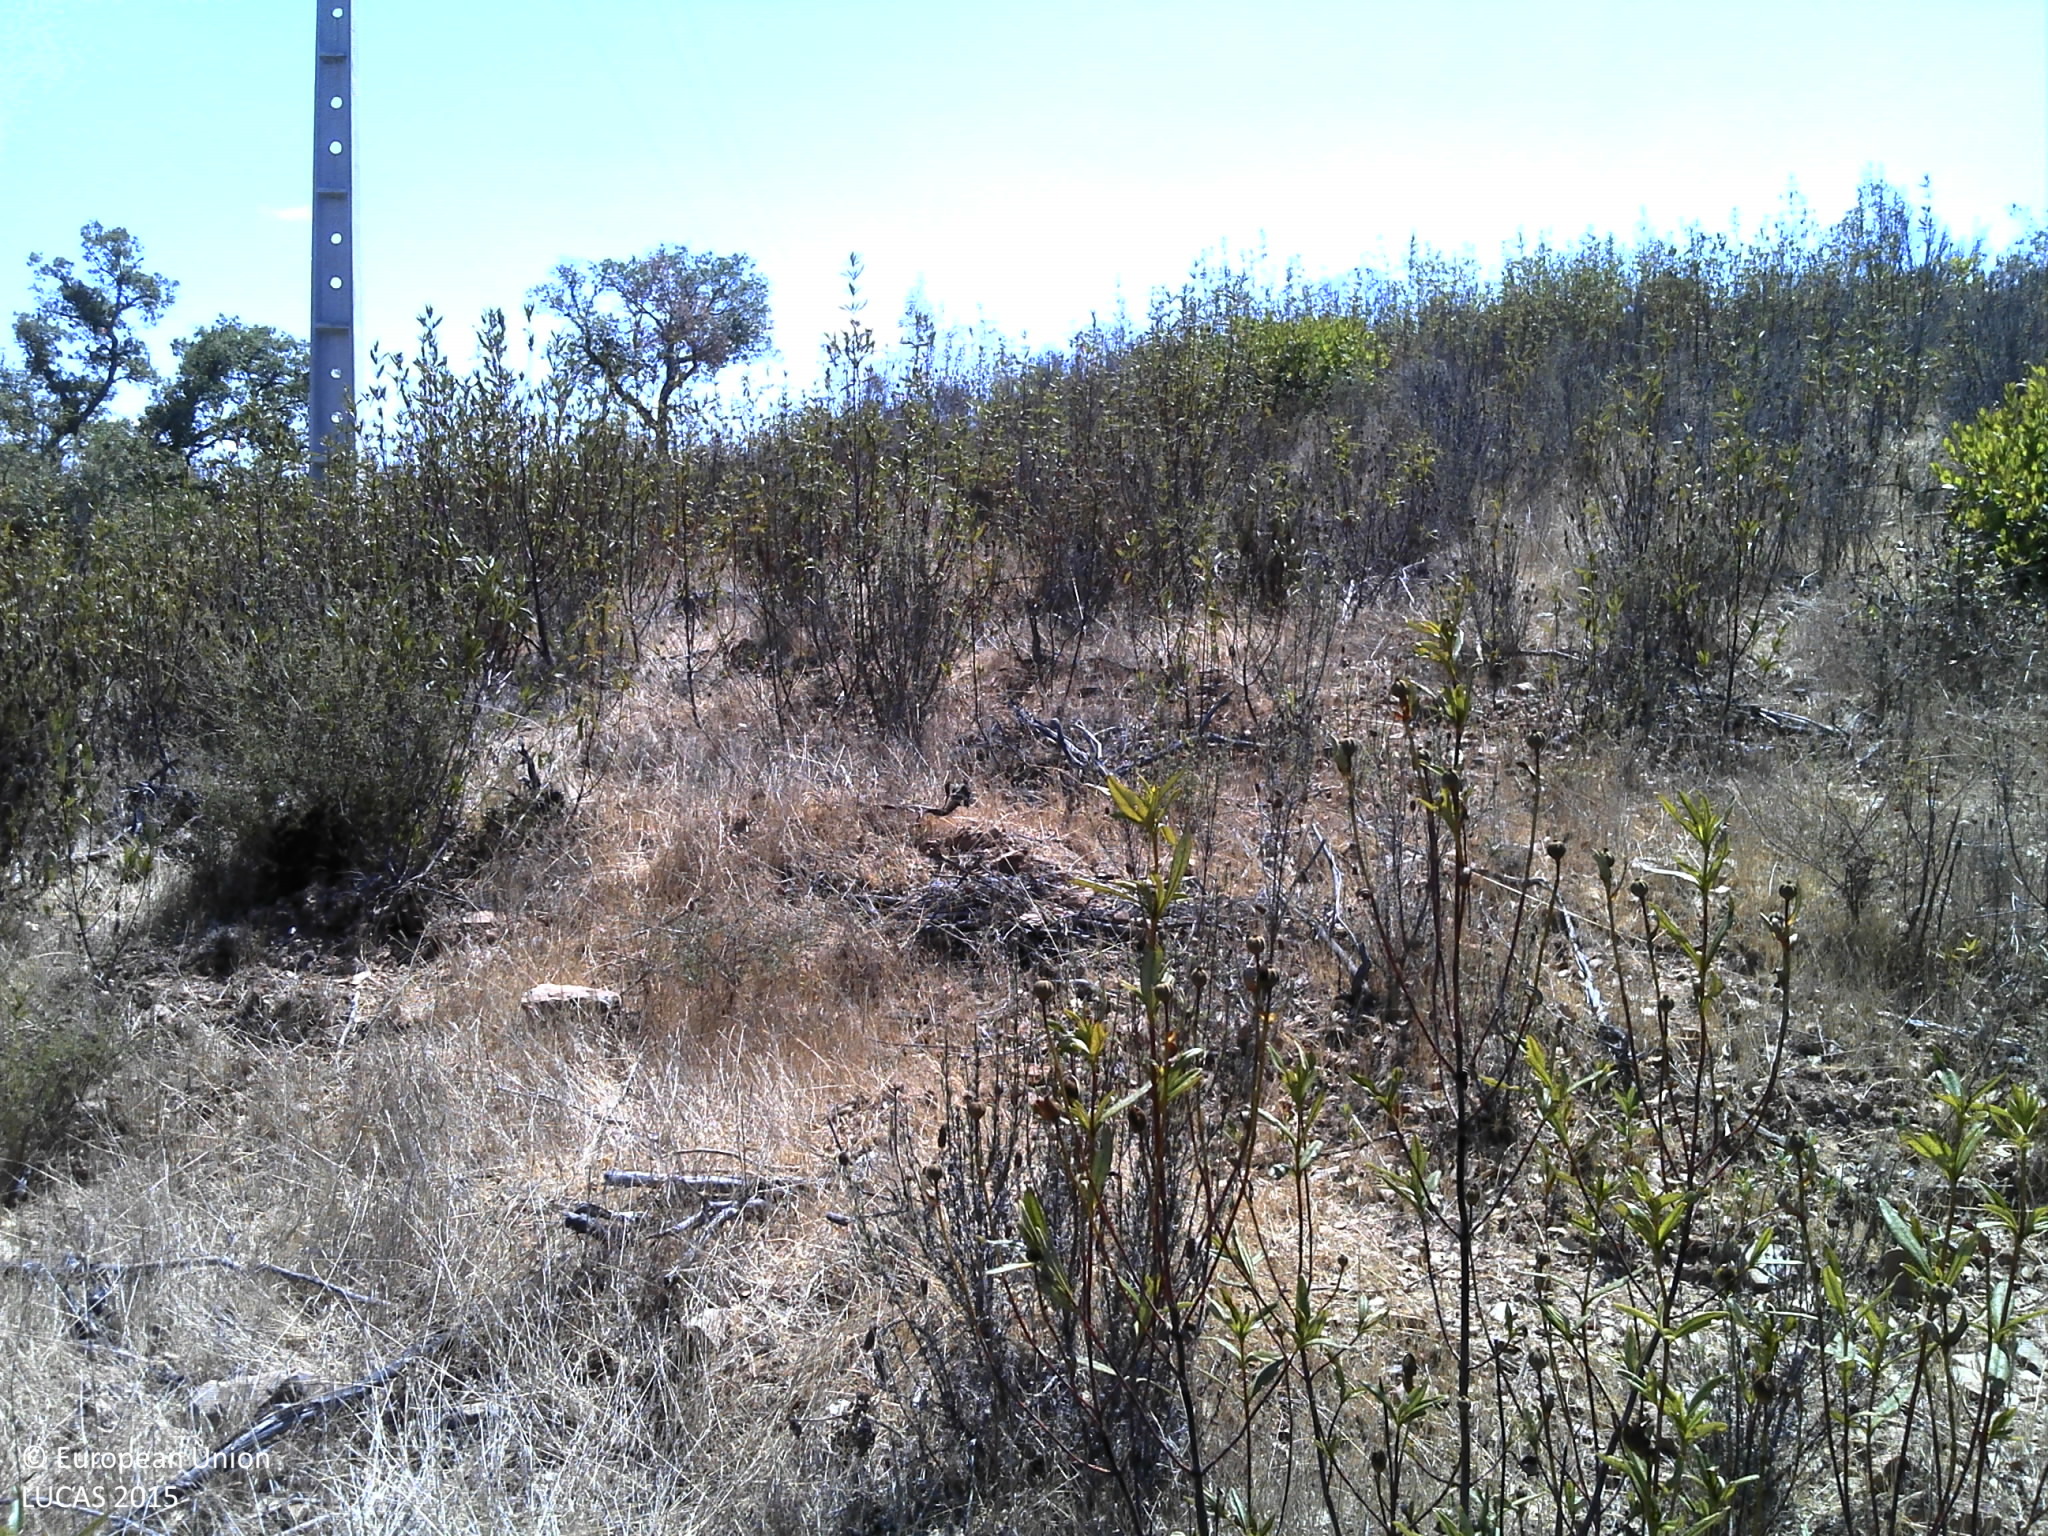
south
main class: Shrubland
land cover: Shrubland with sparse tree cover
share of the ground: 50 - 75 %
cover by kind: shrubs 60 %, unconsolidated bare surface 35 %, broadleaved forest trees 5 %
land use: Forestry
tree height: < 5 m
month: September
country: PT
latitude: 37.4852
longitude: -8.2452
